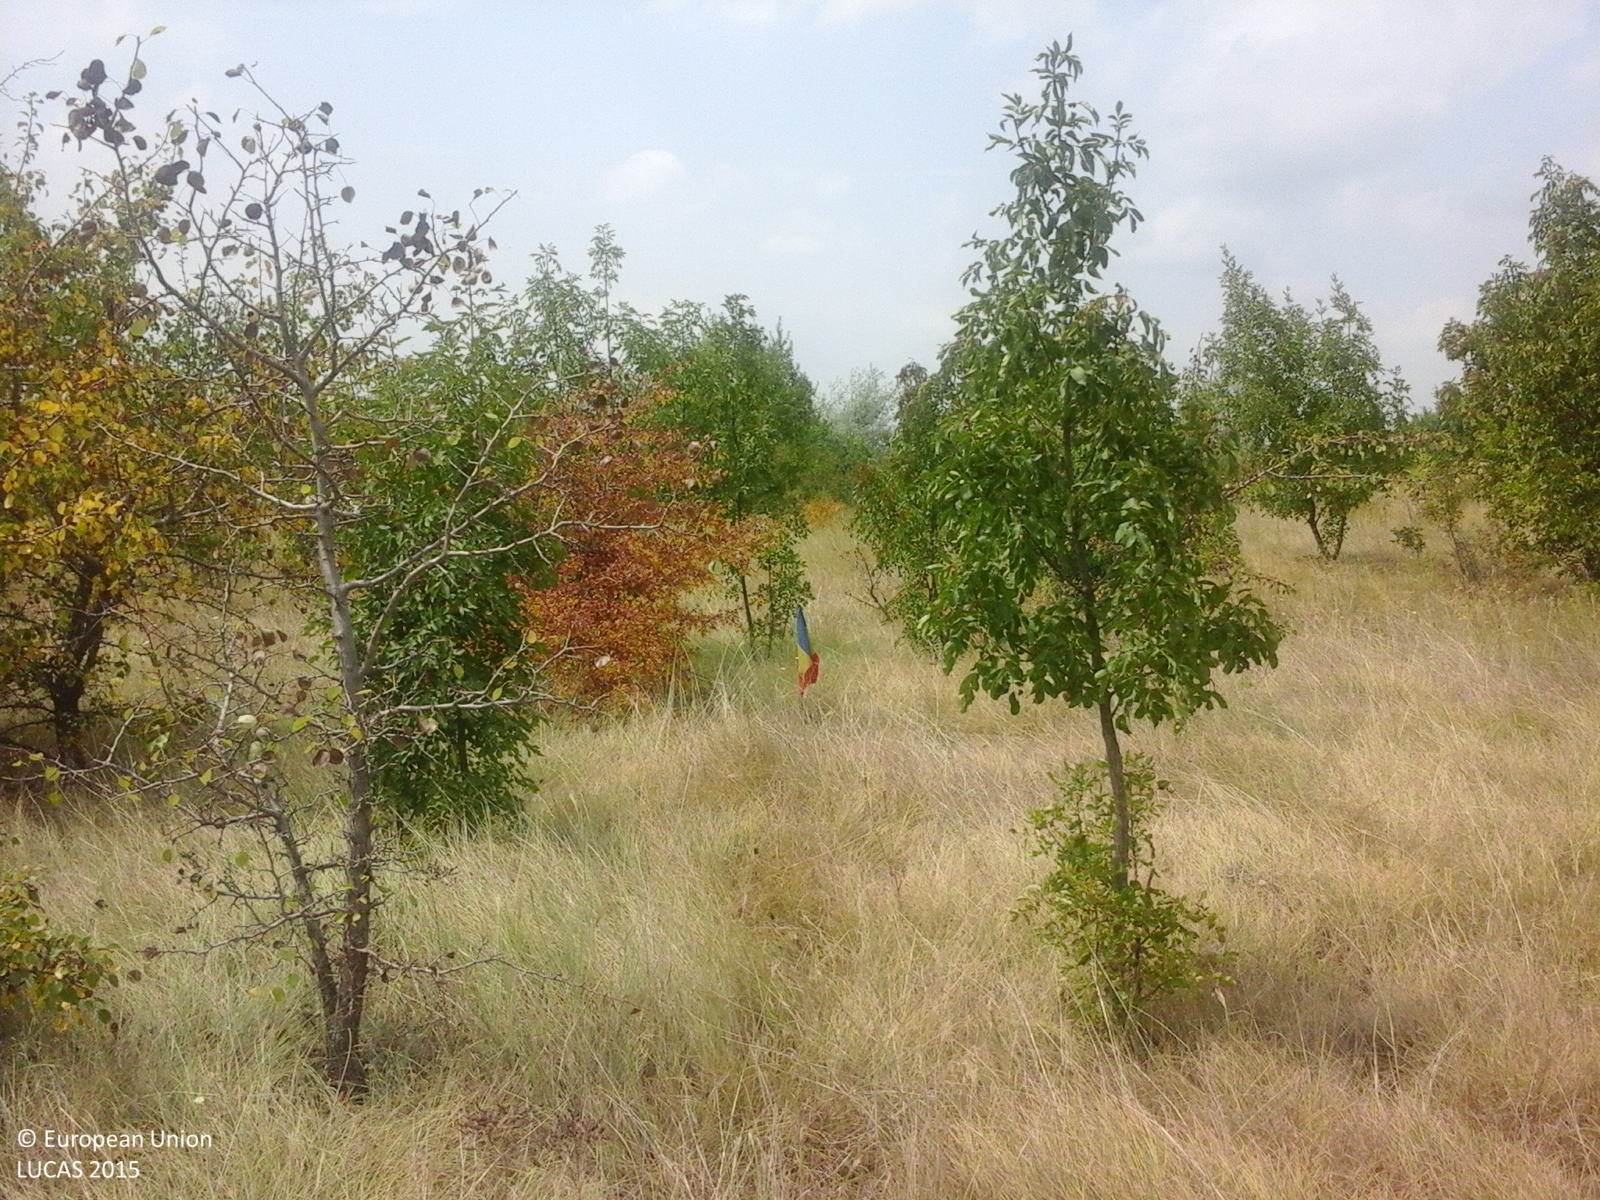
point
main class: Grassland
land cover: Grassland with sparse tree/shrub cover
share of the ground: > 75 %
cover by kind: herbaceous plants 95 %, broadleaved forest trees 5 %
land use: Fallow land
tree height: < 5 m
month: July
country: RO
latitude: 44.9033
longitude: 28.2948
